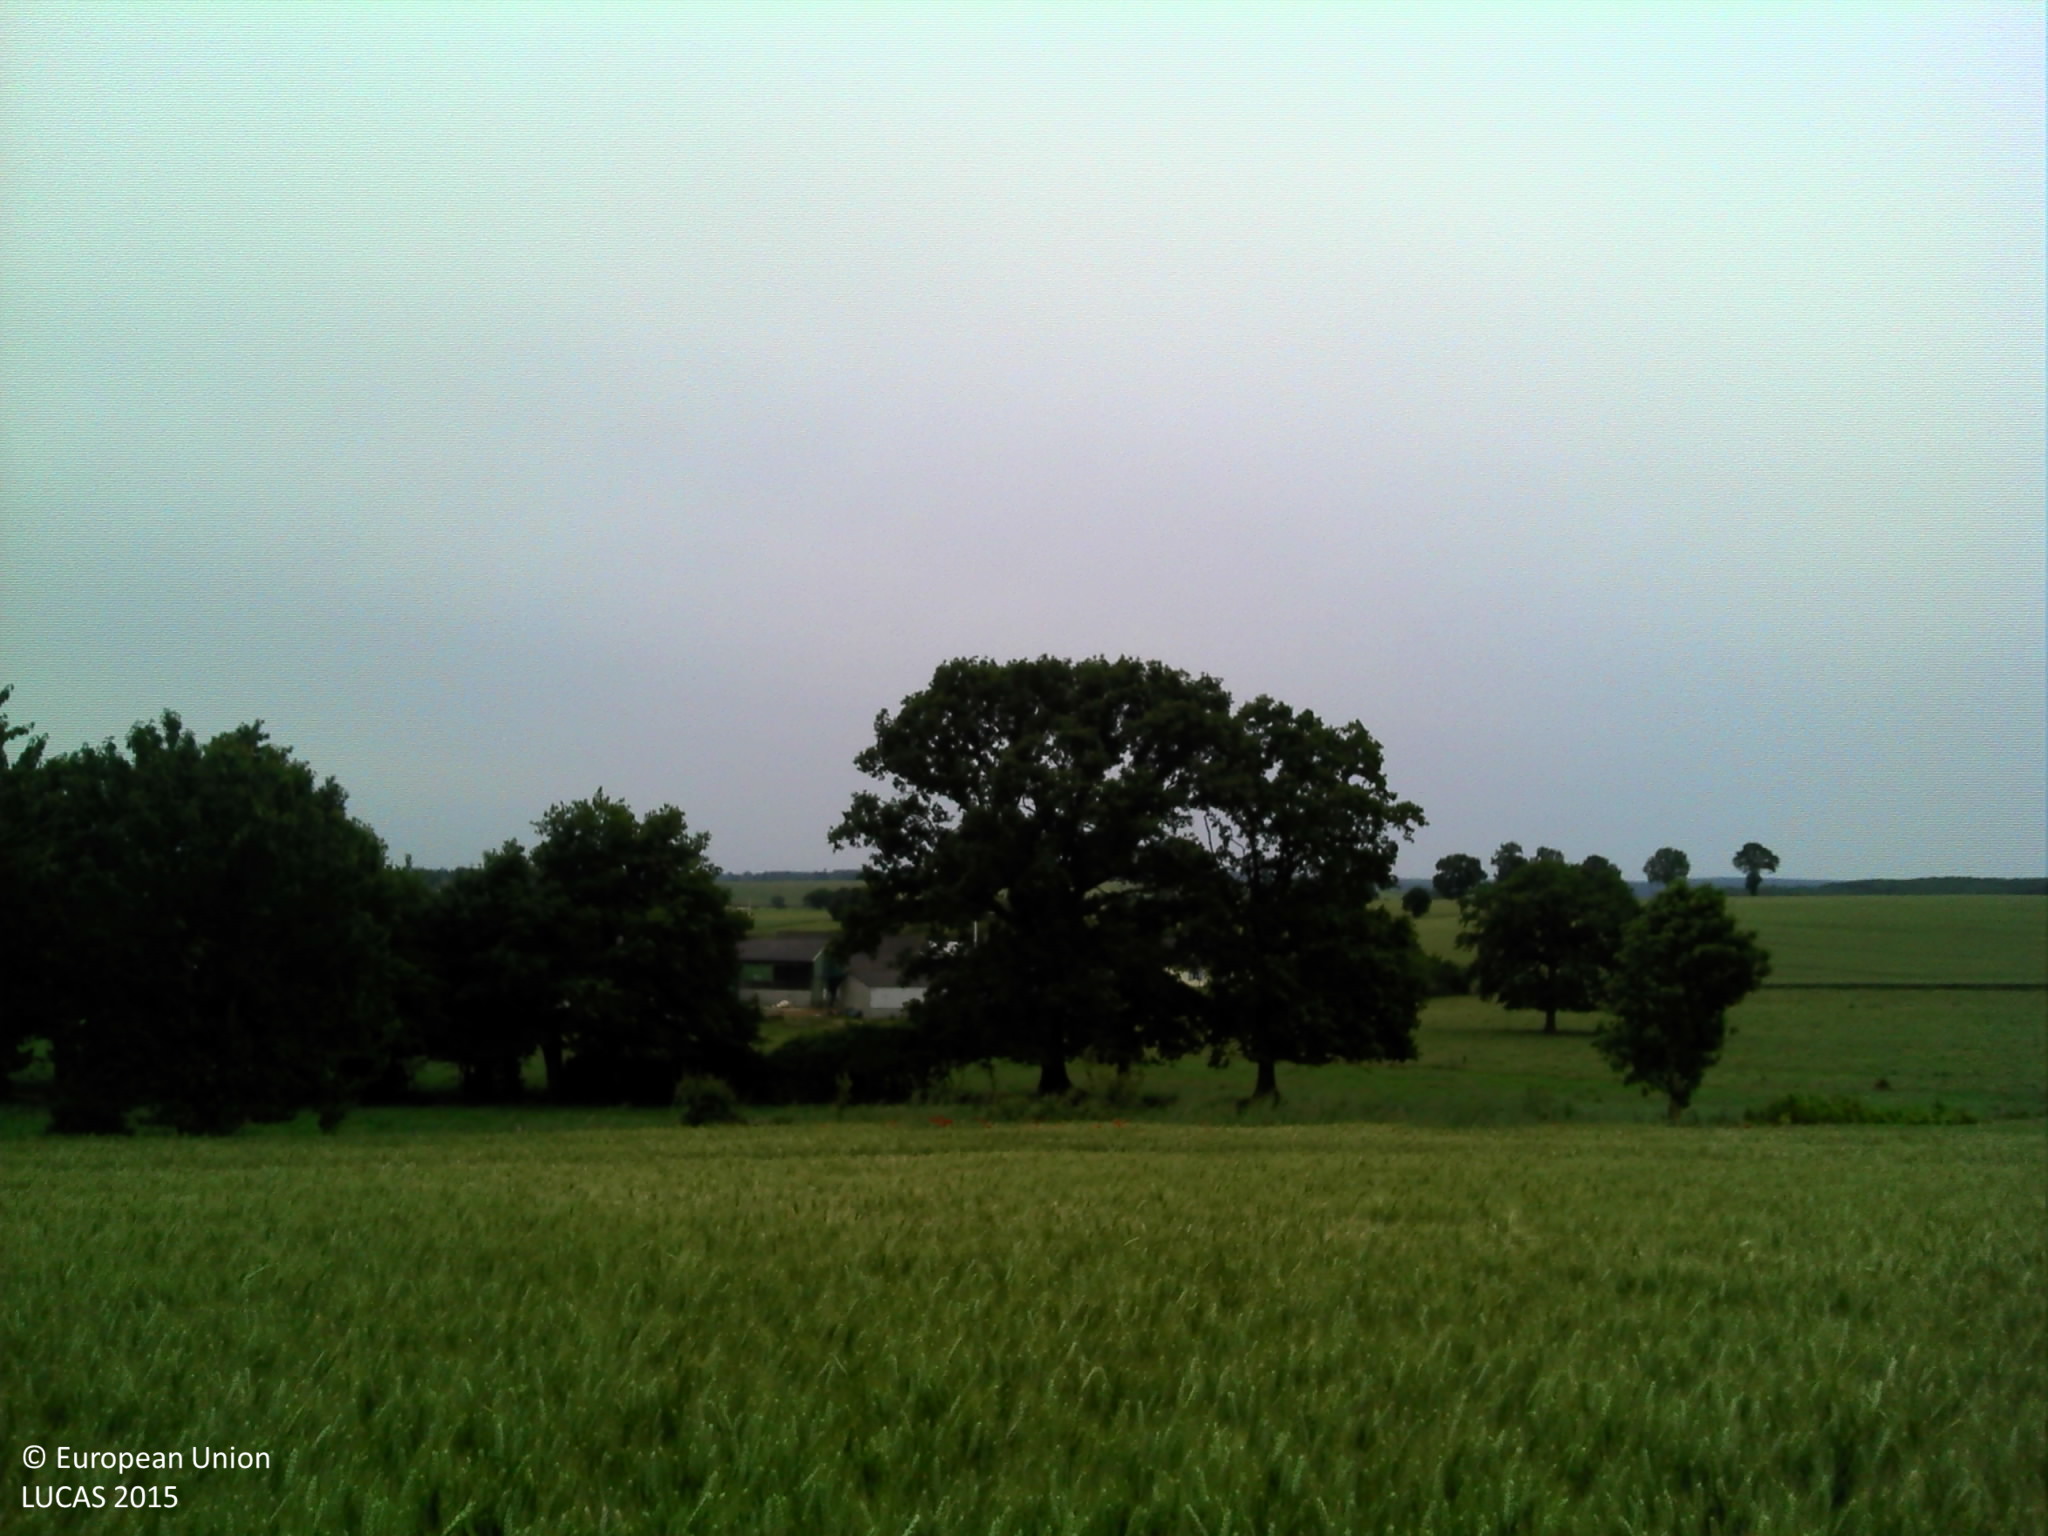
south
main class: Cropland
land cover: Triticale
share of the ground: > 75 %
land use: Agriculture (excluding fallow land and kitchen gardens)
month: June
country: FR
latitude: 48.2871
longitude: -0.0703
